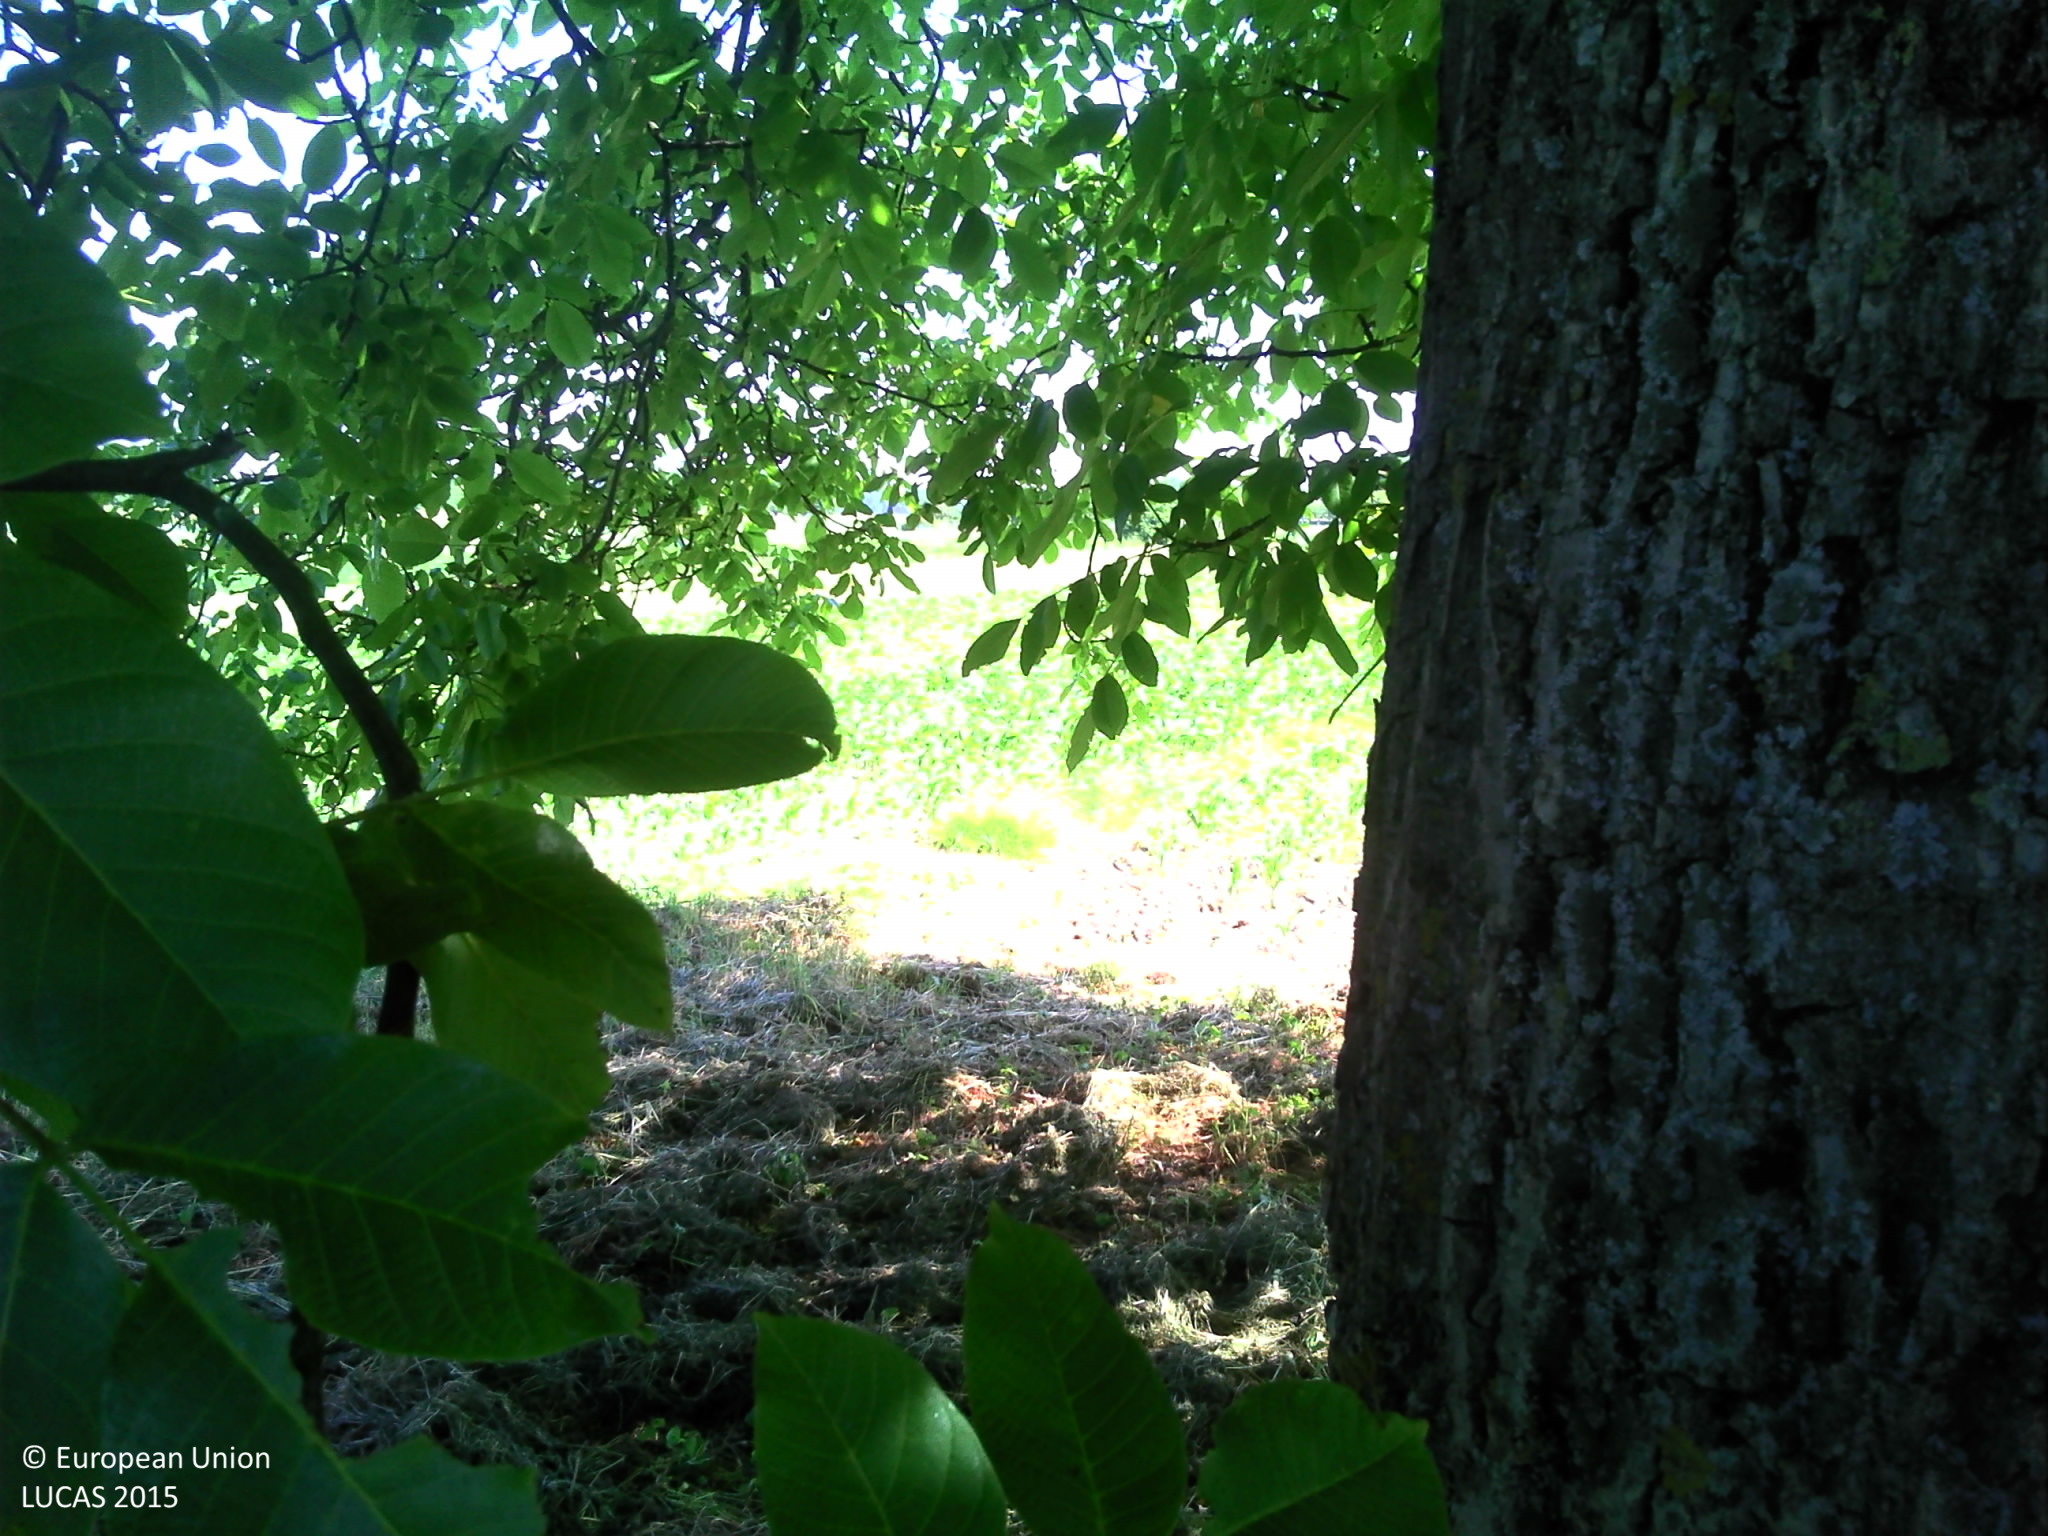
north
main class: Grassland
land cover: Grassland with sparse tree/shrub cover
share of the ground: > 75 %
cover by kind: herbaceous plants 95 %, broadleaved forest trees 5 %
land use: Agriculture (excluding fallow land and kitchen gardens)
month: June
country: FR
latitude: 48.3794
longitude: 7.6921
